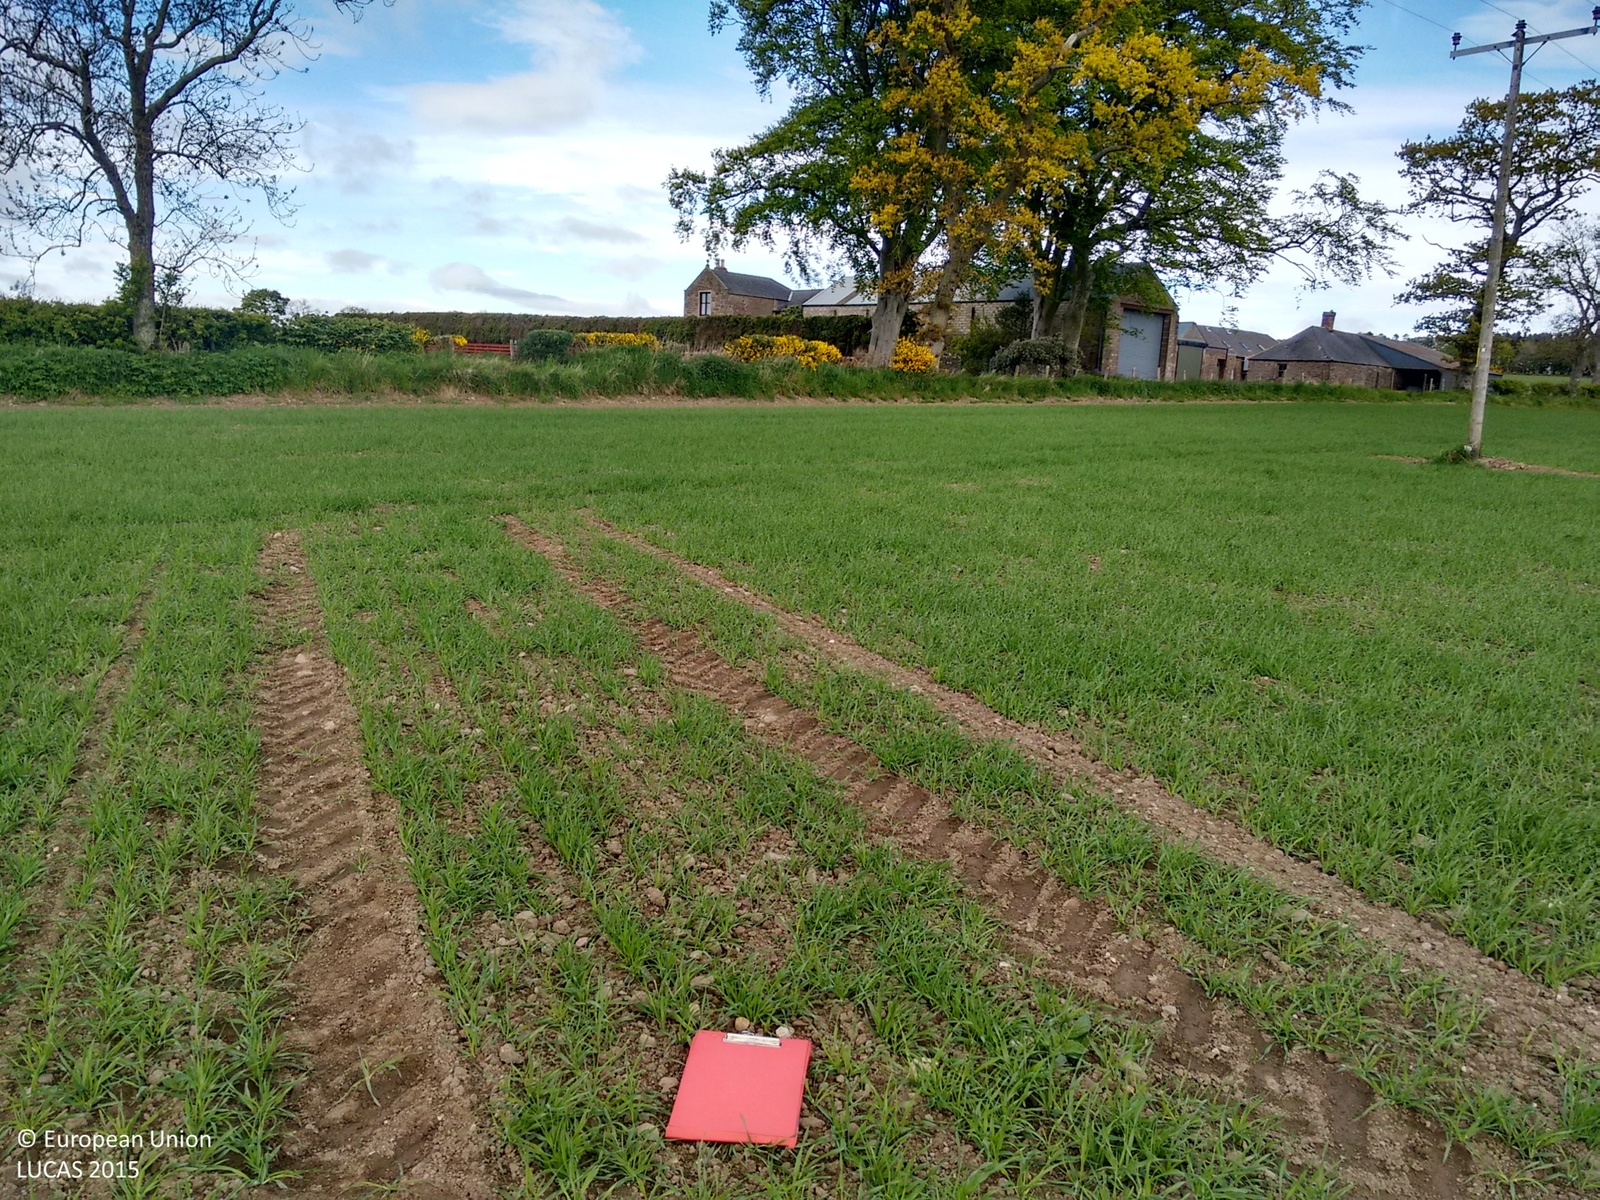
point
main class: Cropland
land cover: Barley
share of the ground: > 75 %
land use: Agriculture (excluding fallow land and kitchen gardens)
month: May
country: GB
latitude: 56.5736
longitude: -2.7075
